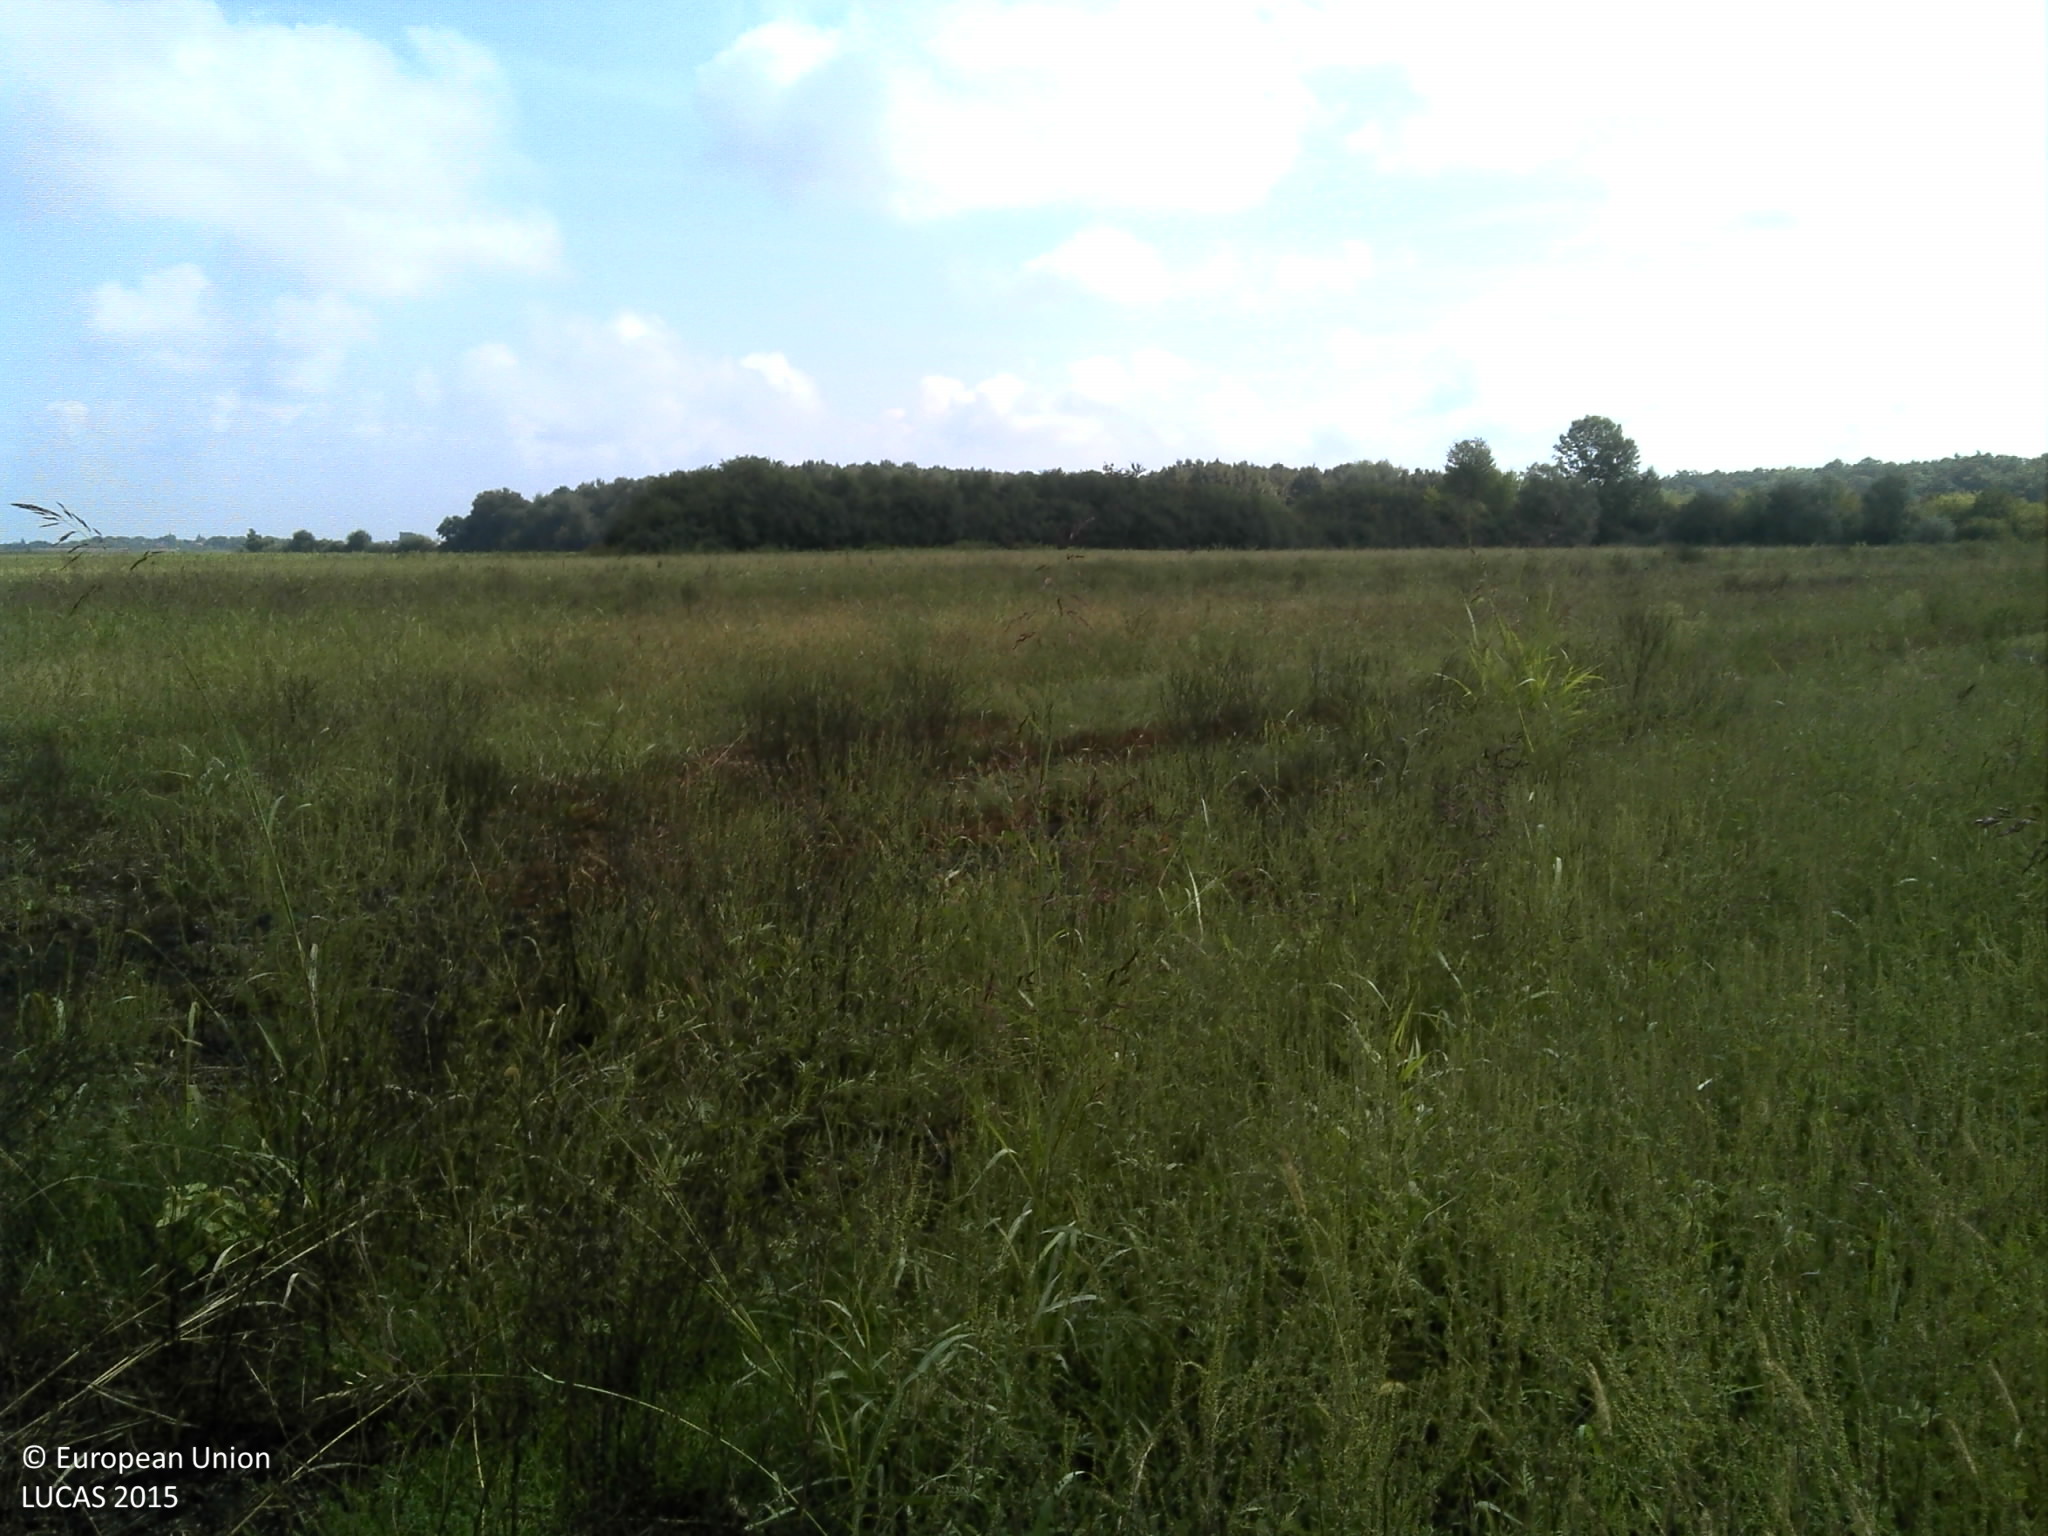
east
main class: Grassland
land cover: Spontaneously vegetated surfaces
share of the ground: > 75 %
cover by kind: herbaceous plants 100 %
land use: Agriculture (excluding fallow land and kitchen gardens)
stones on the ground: < 10 %
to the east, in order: Spontaneously vegetated surfaces; Sugar beet; Shrubland with sparse tree cover
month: September
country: HR
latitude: 45.1219
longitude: 18.9701
